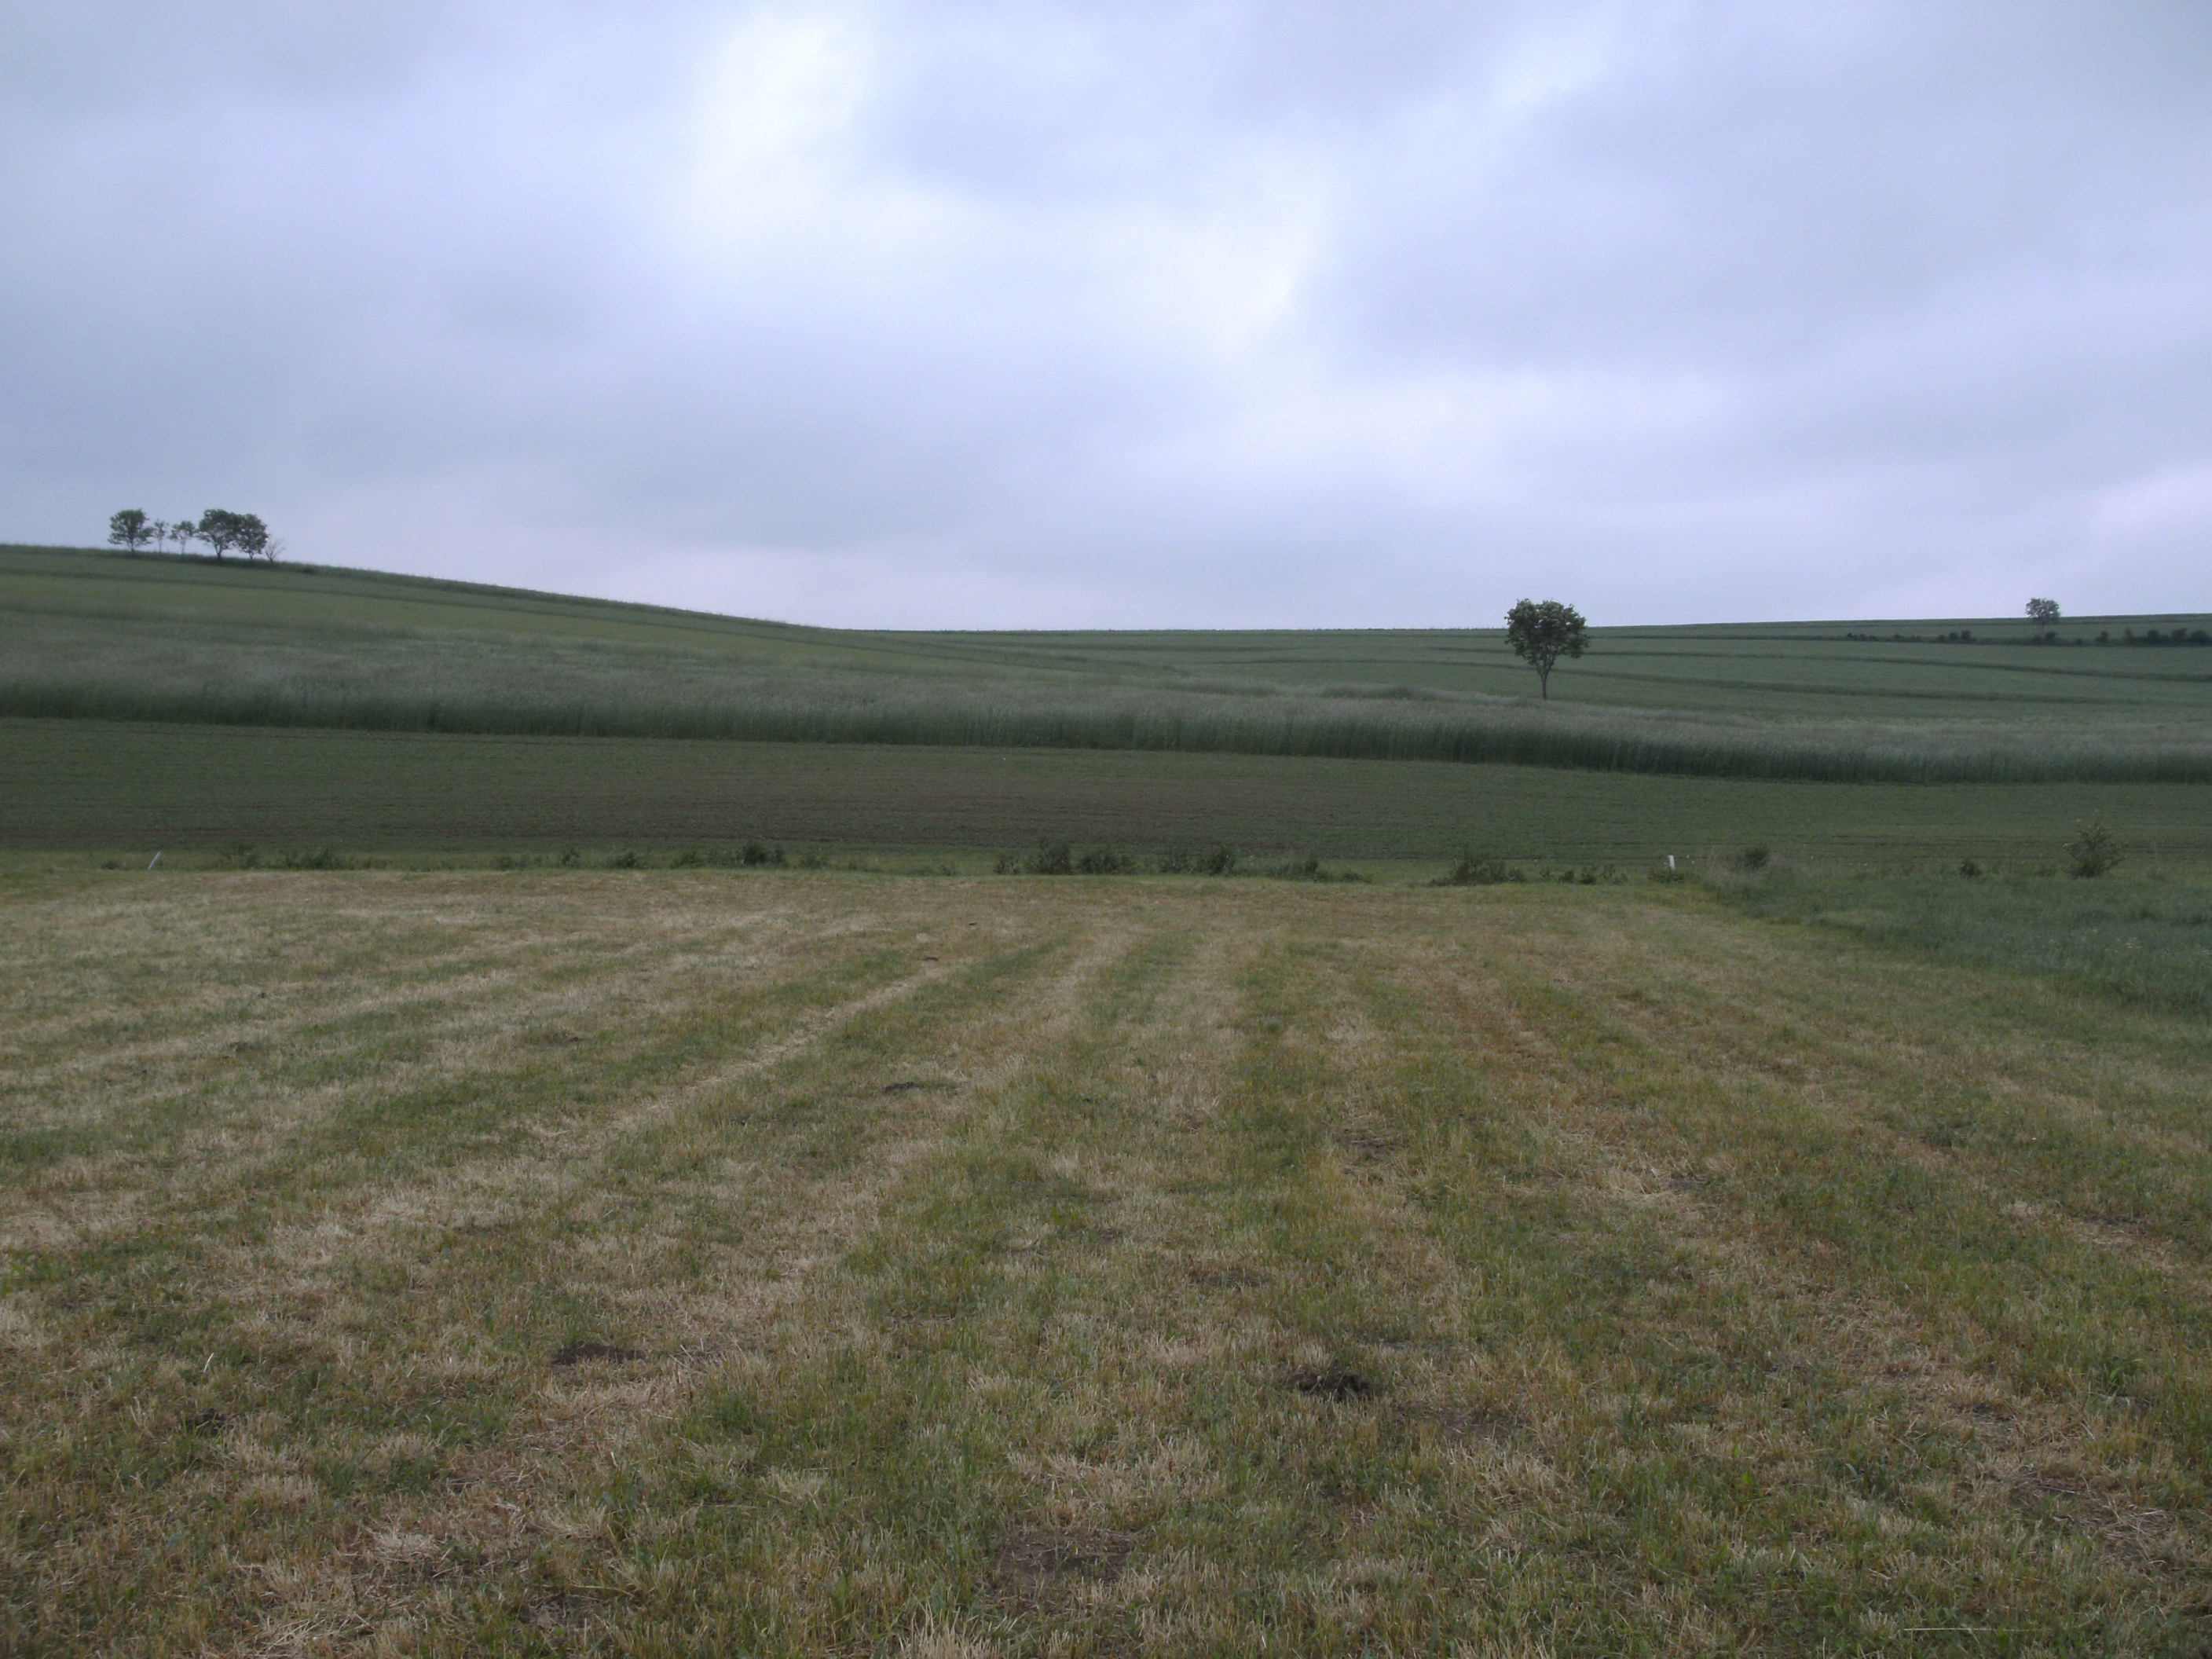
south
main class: Grassland
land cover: Grassland without tree/shrub cover
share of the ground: > 75 %
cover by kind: herbaceous plants 100 %
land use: Agriculture (excluding fallow land and kitchen gardens)
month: June
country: AT
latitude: 48.5004
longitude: 14.2906
